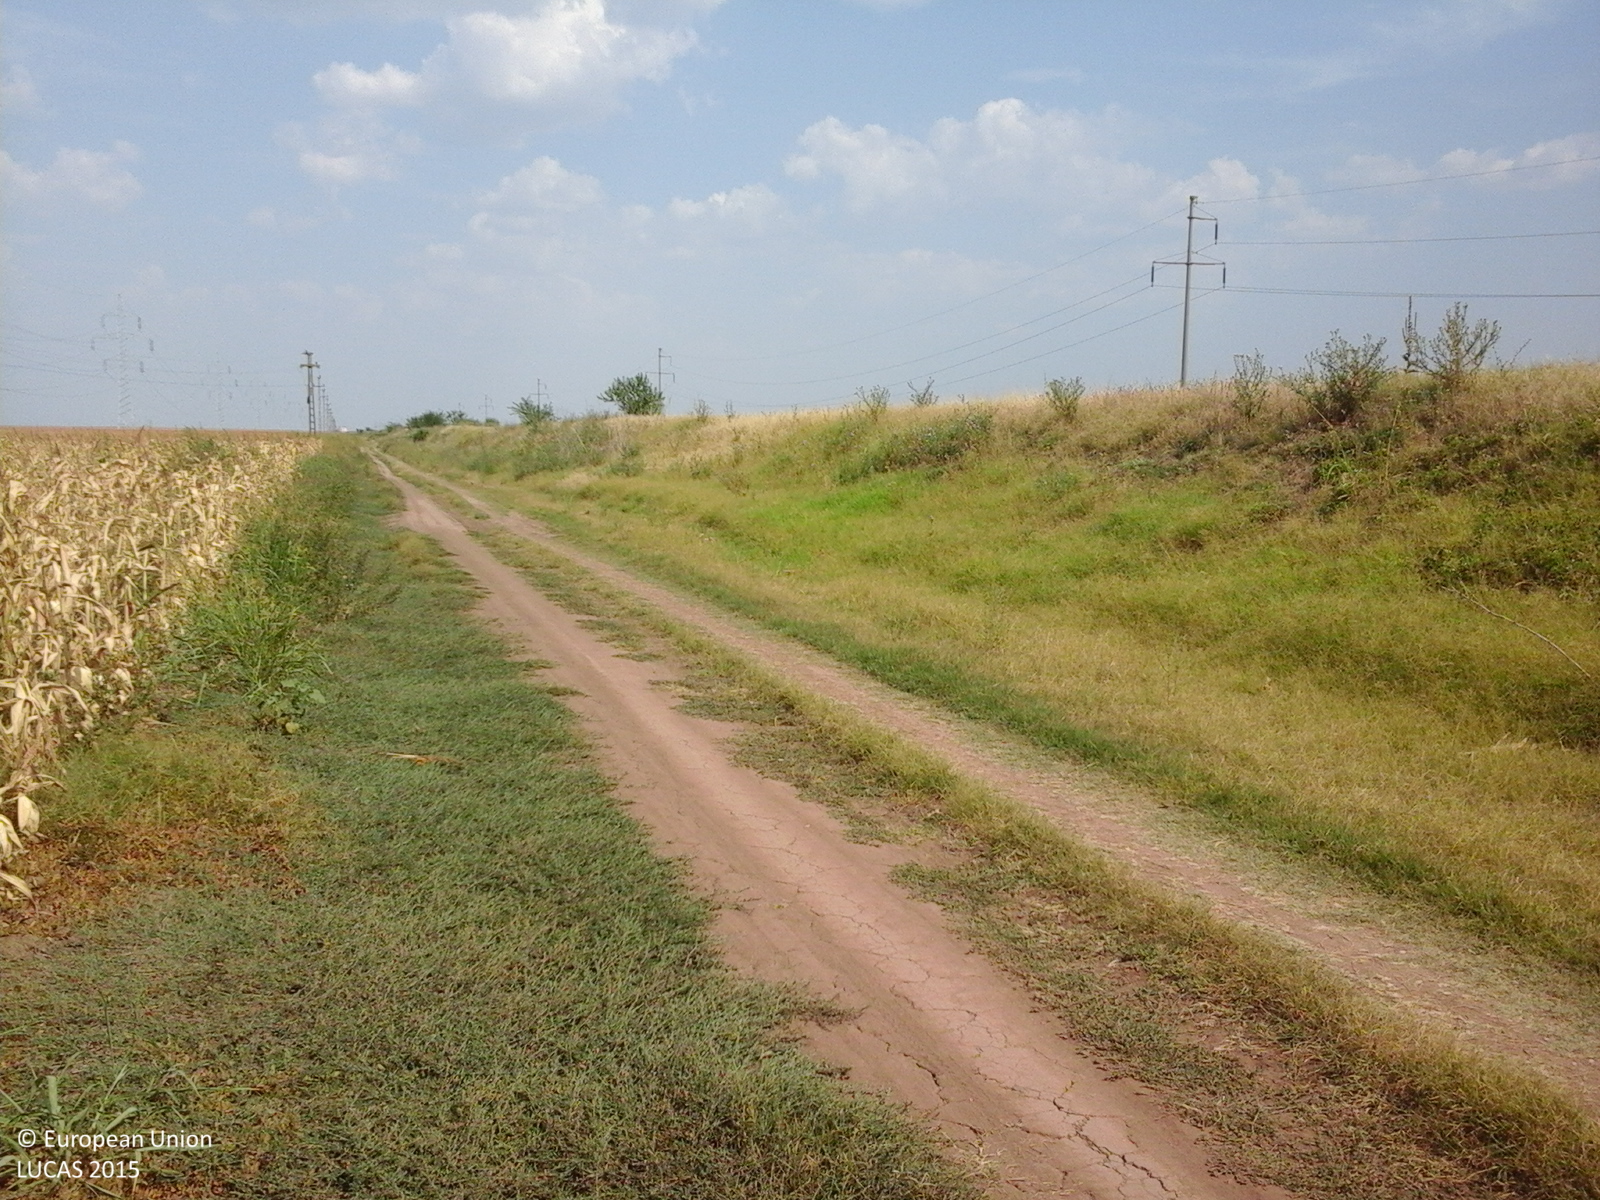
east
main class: Cropland
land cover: Maize
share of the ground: > 75 %
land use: Agriculture (excluding fallow land and kitchen gardens)
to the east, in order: Maize
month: August
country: RO
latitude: 44.1213
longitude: 23.0773
